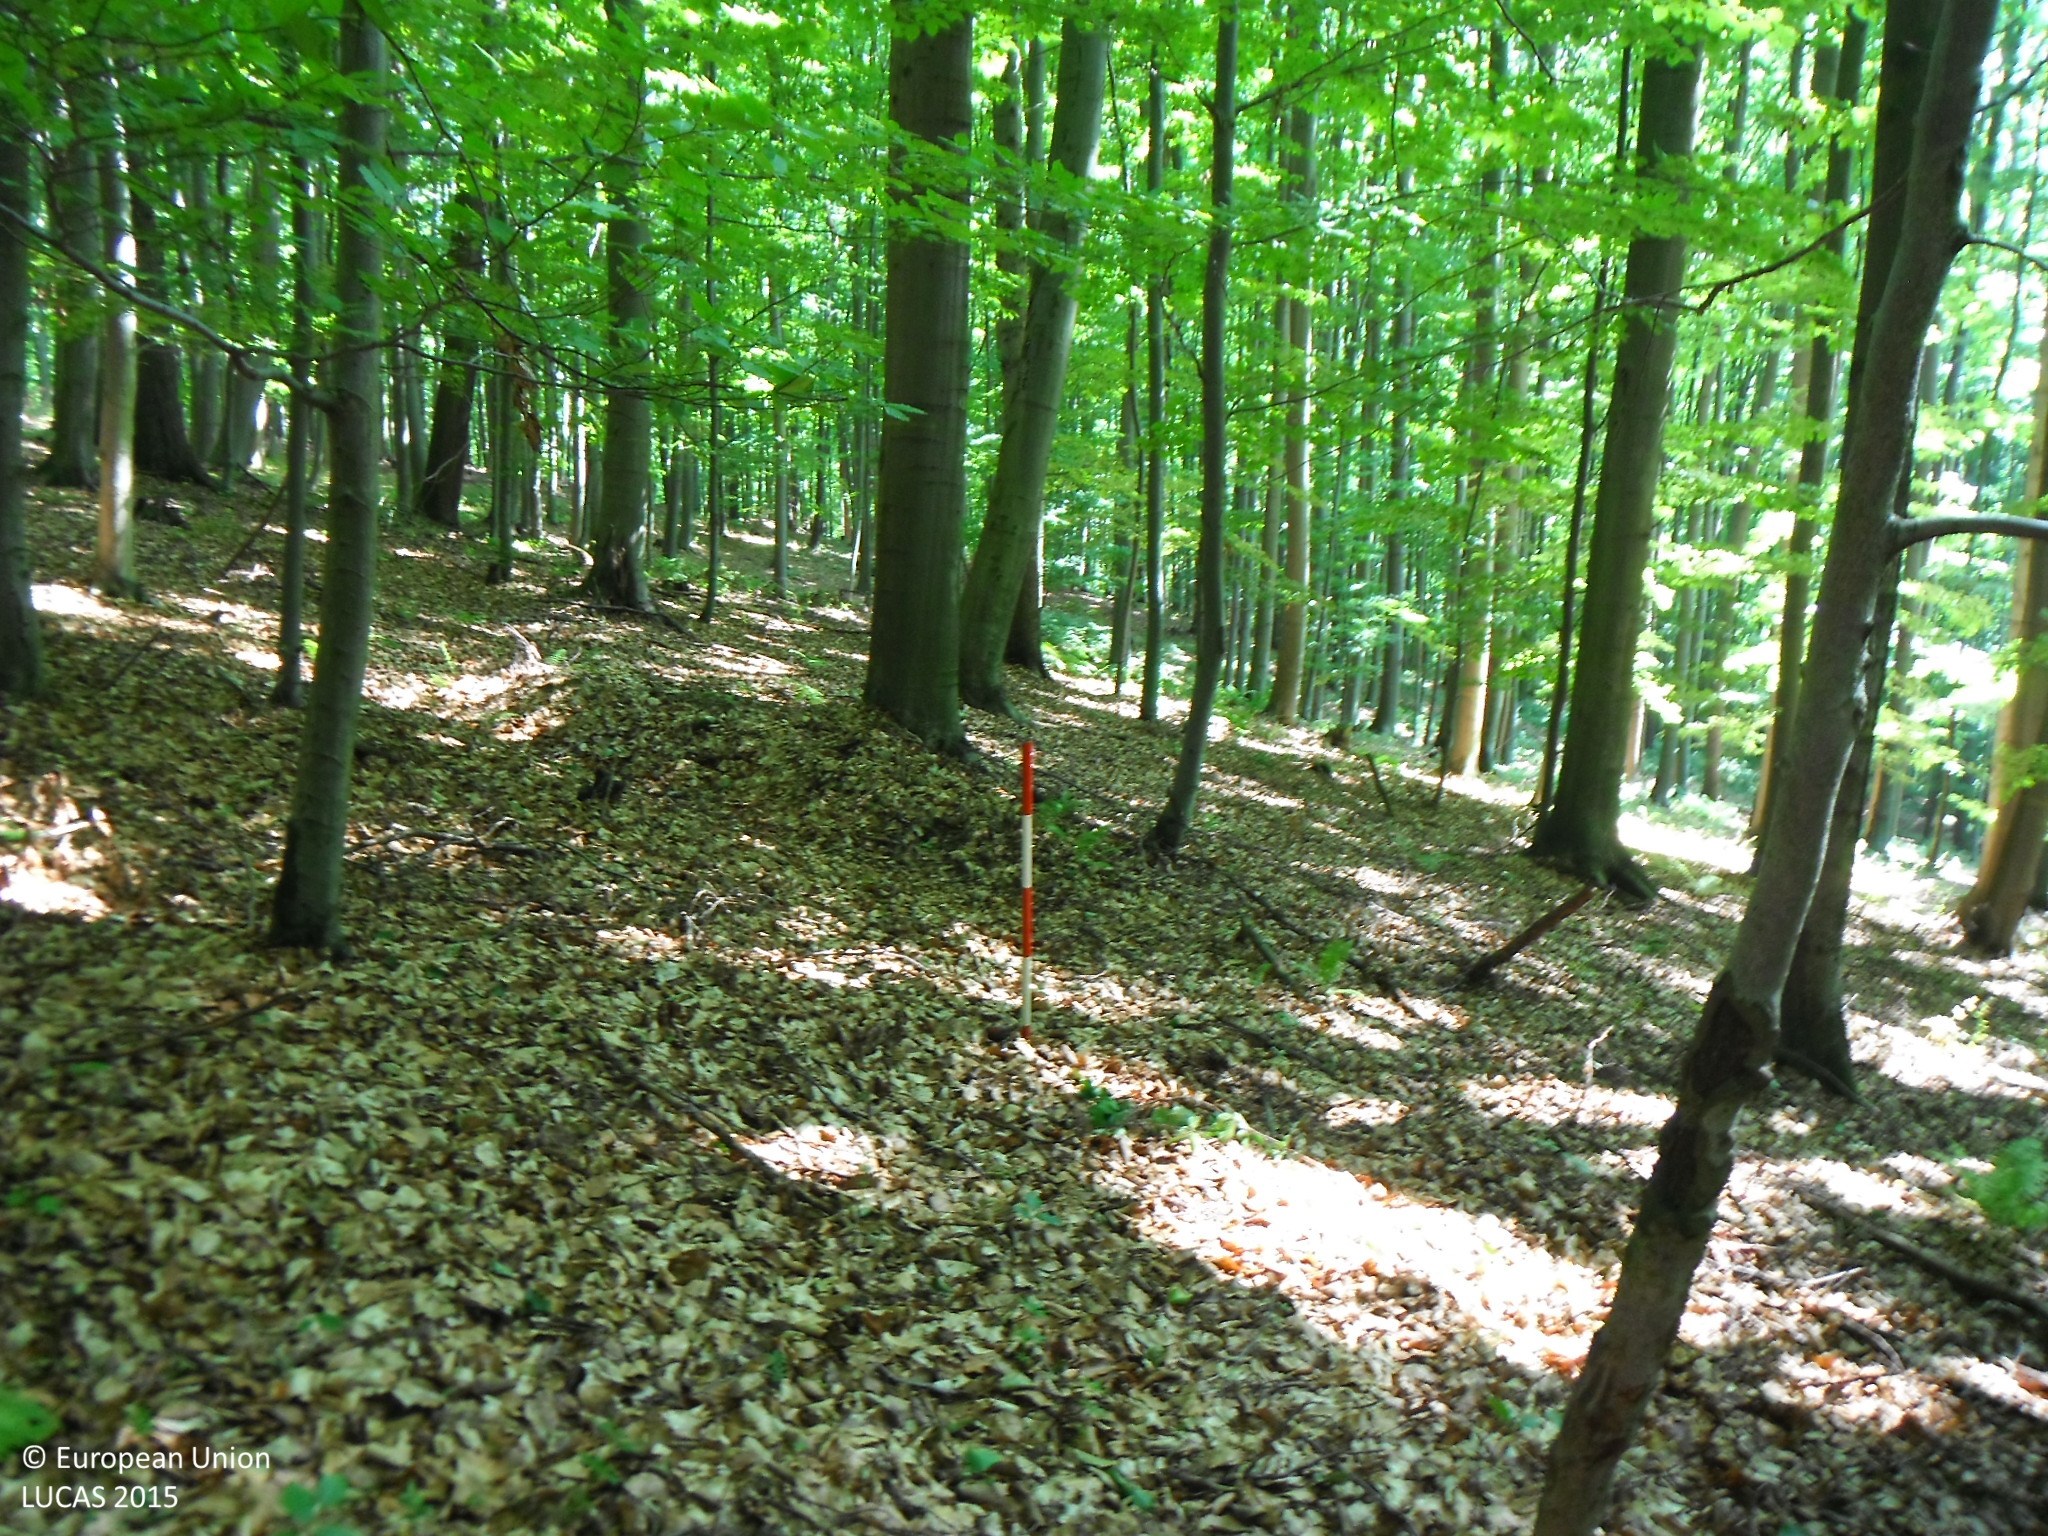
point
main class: Woodland
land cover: Broadleaved woodland
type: mesophytic deciduous forest
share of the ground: > 75 %
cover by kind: broadleaved forest trees 80 %, coniferous forest trees 20 %
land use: Forestry
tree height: > 5 m
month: July
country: SK
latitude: 49.2628
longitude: 21.2449
